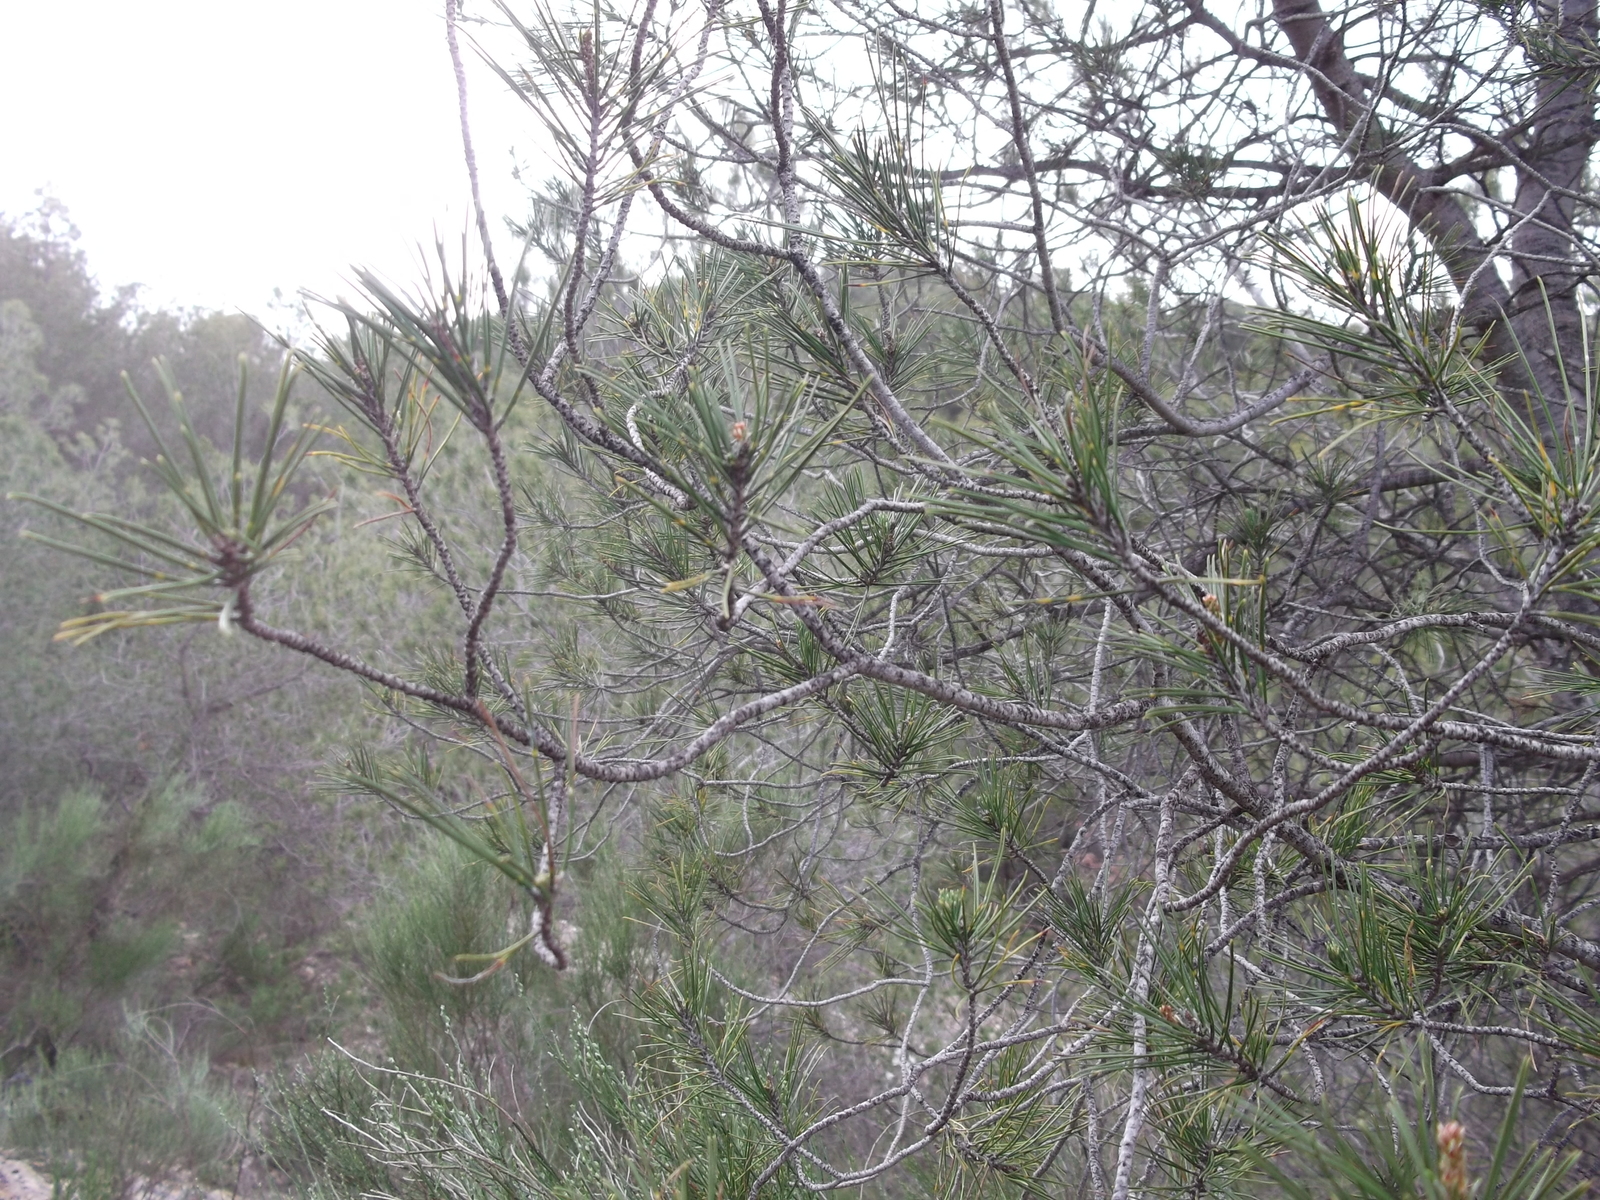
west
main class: Woodland
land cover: Pine dominated coniferous woodland
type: coniferous forest of the mediterranean region
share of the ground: 25 - 50 %
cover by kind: shrubs 70 %, coniferous forest trees 30 %
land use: Forestry
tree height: > 5 m
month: April
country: ES
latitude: 37.9425
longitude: -1.5121
